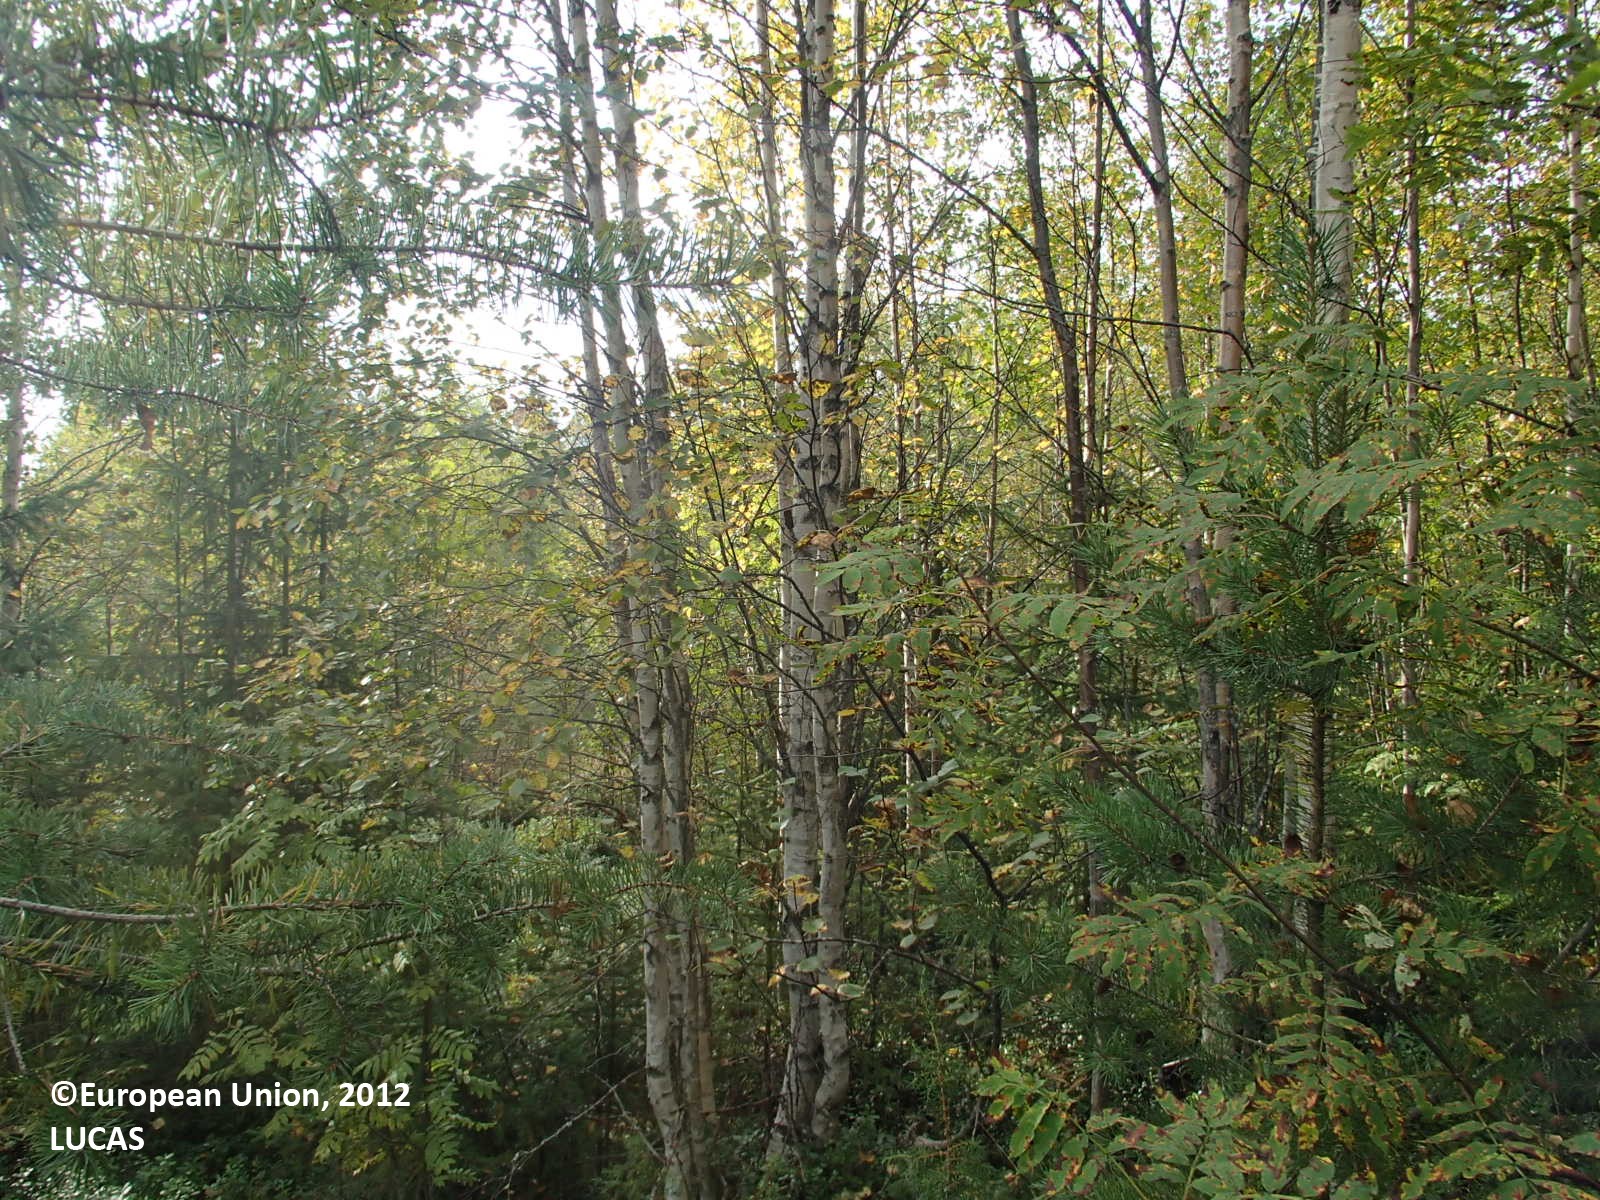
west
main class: Woodland
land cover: Spruce dominated mixed woodland
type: boreal forest
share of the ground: > 75 %
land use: Forestry
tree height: > 5 m
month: August
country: FI
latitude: 63.7380
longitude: 27.0953
